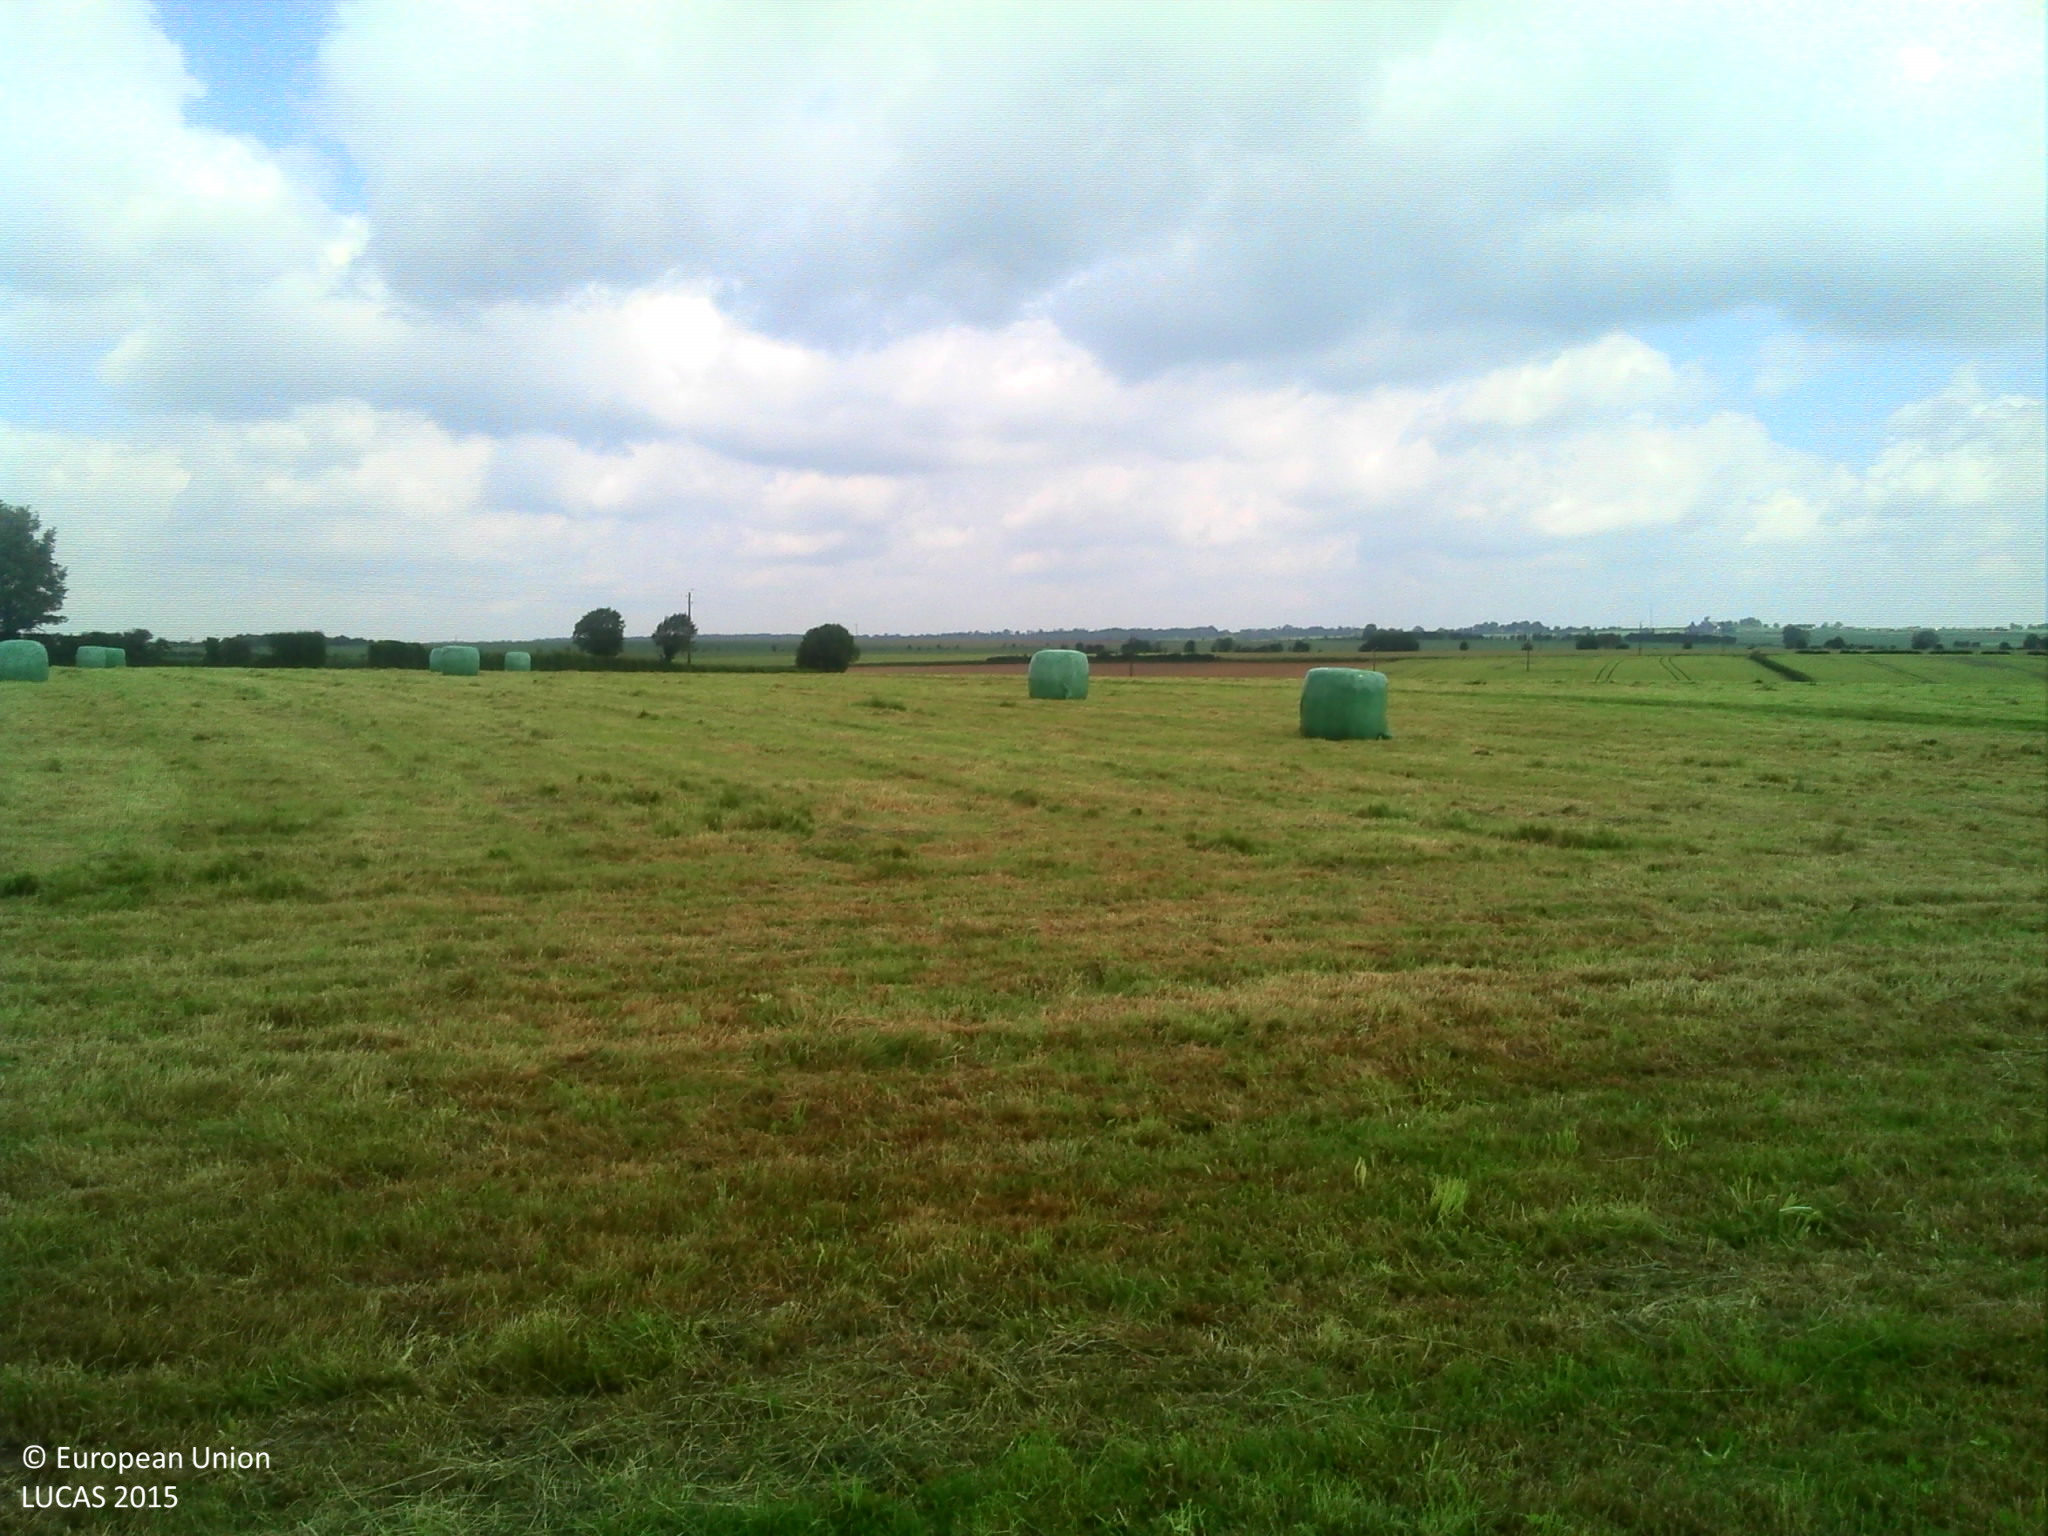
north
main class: Grassland
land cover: Grassland without tree/shrub cover
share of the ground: > 75 %
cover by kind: herbaceous plants 100 %
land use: Agriculture (excluding fallow land and kitchen gardens)
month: May
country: FR
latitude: 48.7879
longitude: -0.1448
